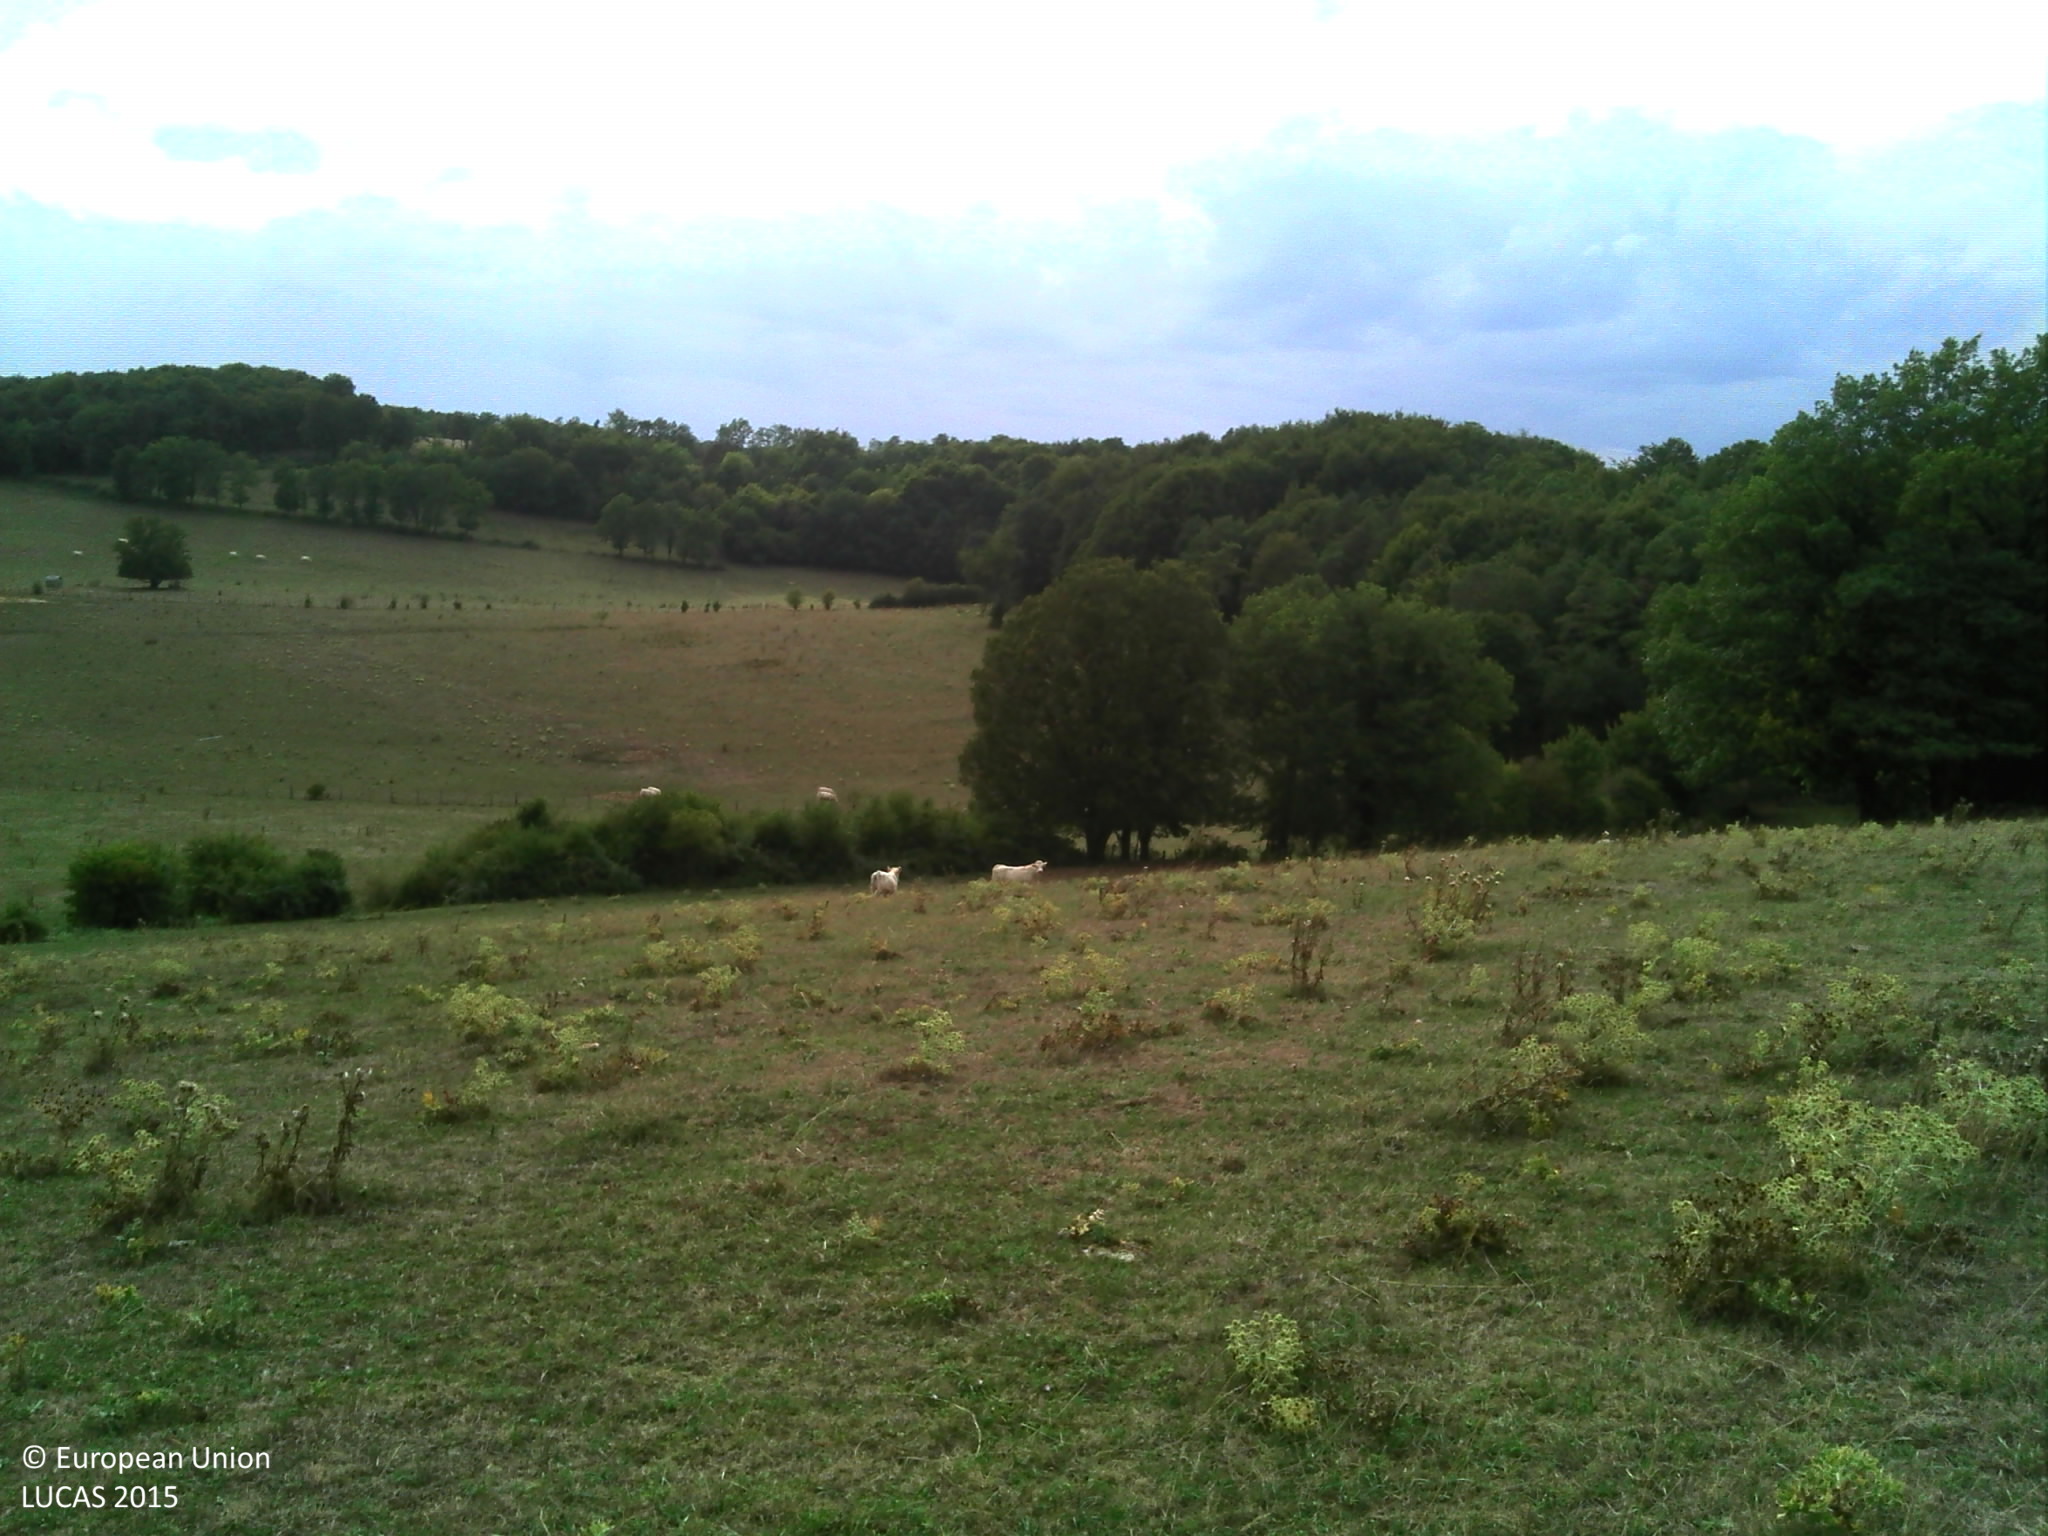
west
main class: Grassland
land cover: Grassland without tree/shrub cover
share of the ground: > 75 %
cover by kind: herbaceous plants 100 %
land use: Agriculture (excluding fallow land and kitchen gardens)
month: August
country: FR
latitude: 47.7074
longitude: 4.8683
